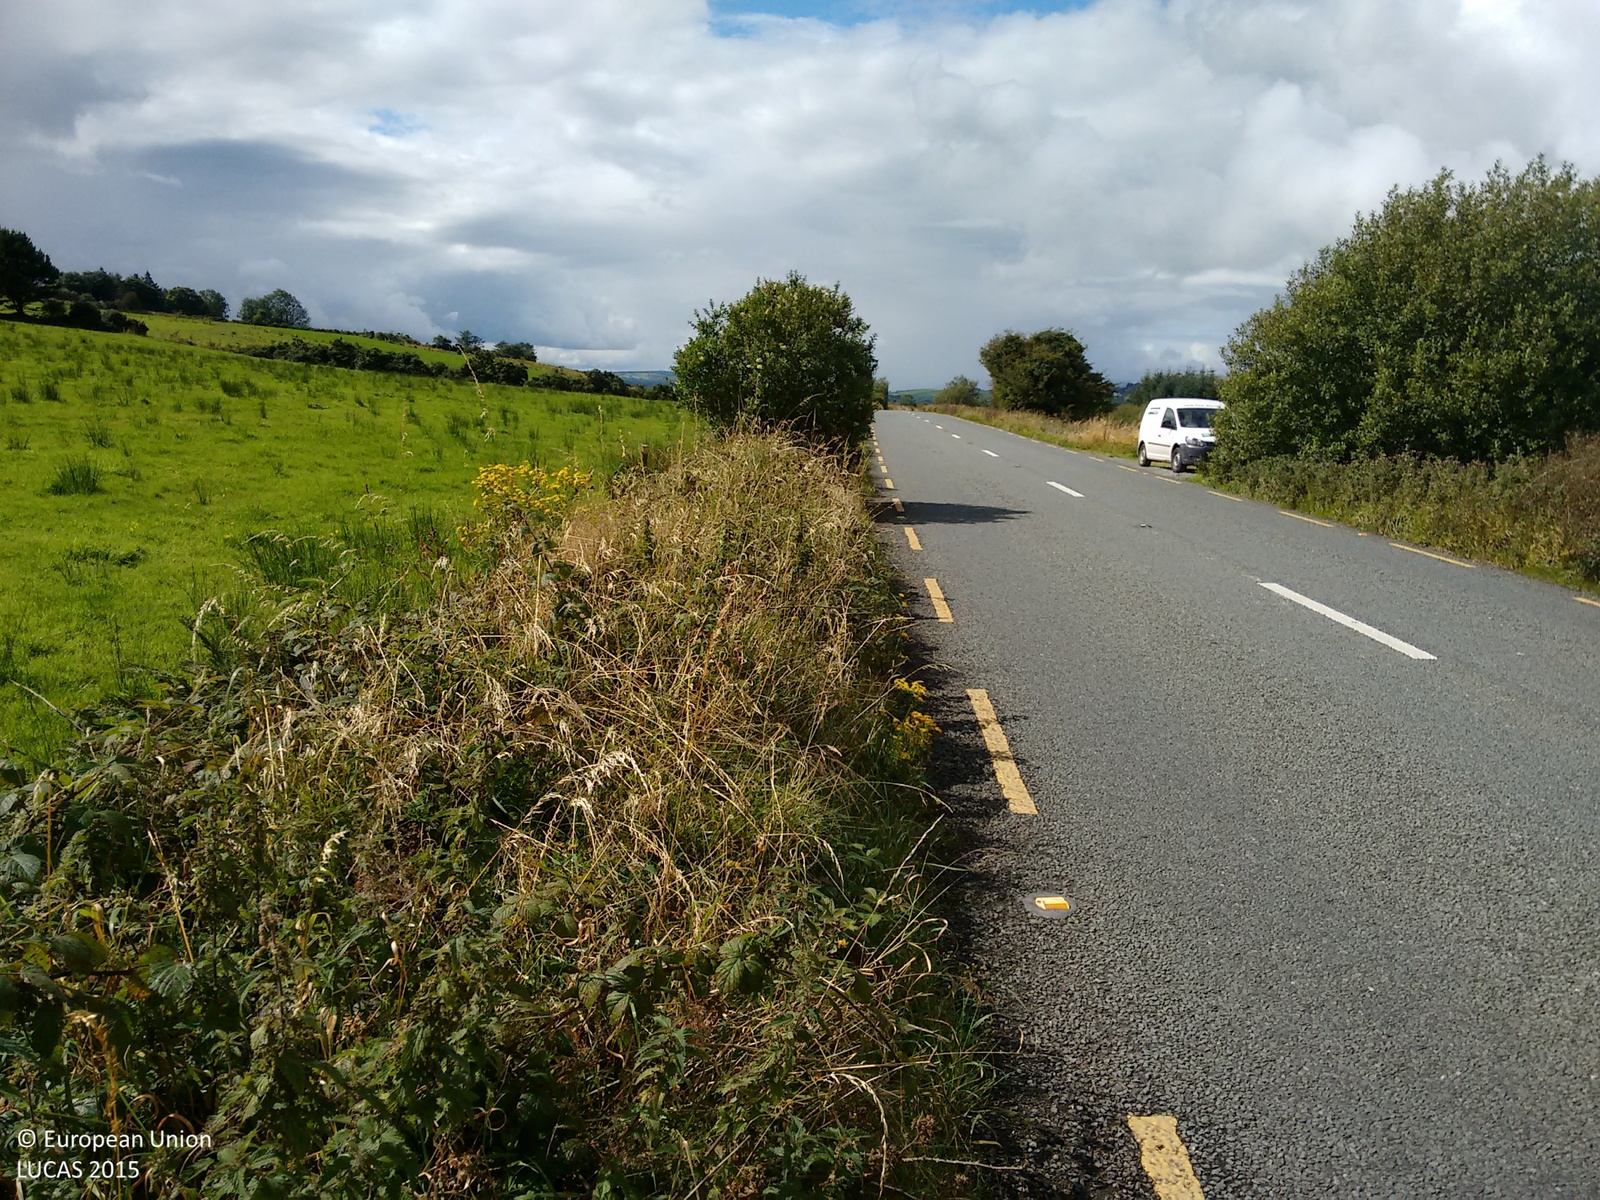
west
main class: Grassland
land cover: Grassland without tree/shrub cover
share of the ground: > 75 %
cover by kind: herbaceous plants 100 %
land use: Agriculture (excluding fallow land and kitchen gardens)
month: August
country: IE
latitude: 52.1720
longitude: -9.3374
